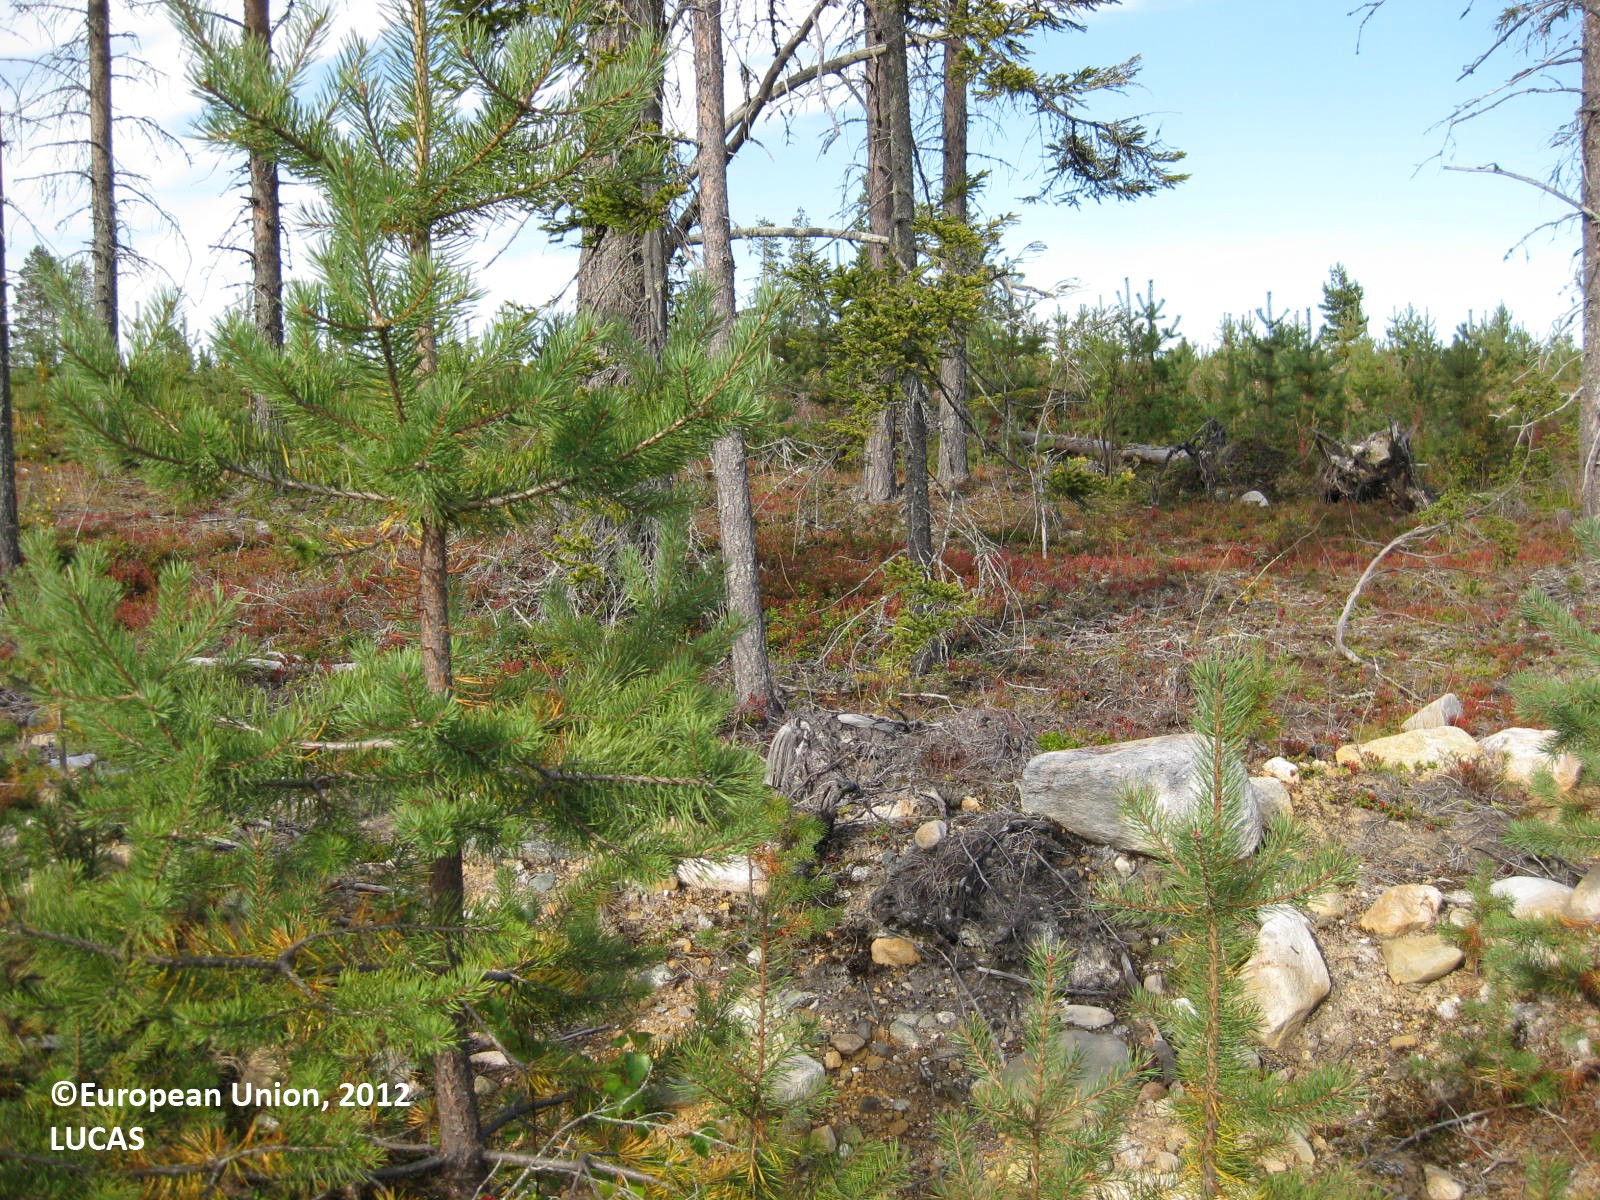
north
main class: Woodland
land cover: Pine dominated coniferous woodland
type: boreal forest
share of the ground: 50 - 75 %
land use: Forestry
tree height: < 5 m
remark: Clear cut
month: August
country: FI
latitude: 65.8890
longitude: 28.7002
